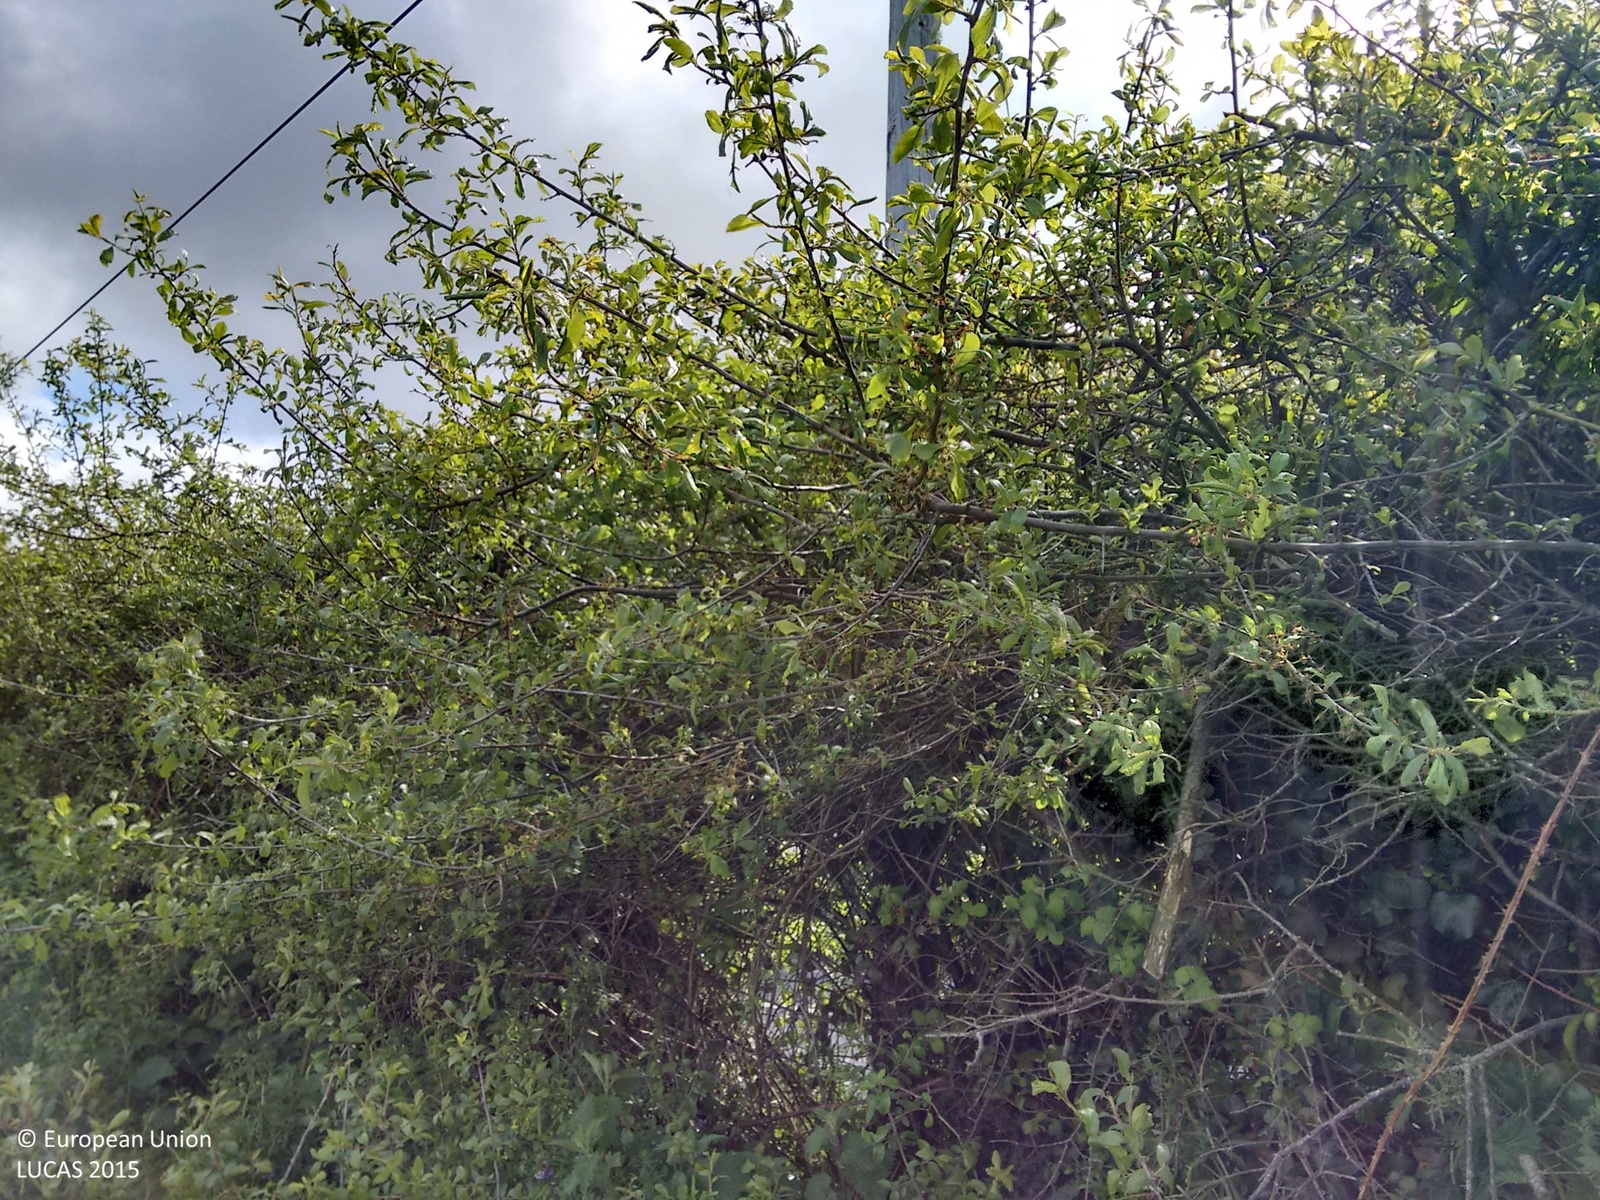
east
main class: Cropland
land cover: Barley
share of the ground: 50 - 75 %
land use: Agriculture (excluding fallow land and kitchen gardens)
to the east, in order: Barley; Managed hedges; Electric lines; Grass margins; Tracks; Paved roads, cycling and walking lanes; Grass margins; Electric lines; Ditches and canals; Managed hedges; Barley
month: May
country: IE
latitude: 53.3061
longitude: -6.4996
